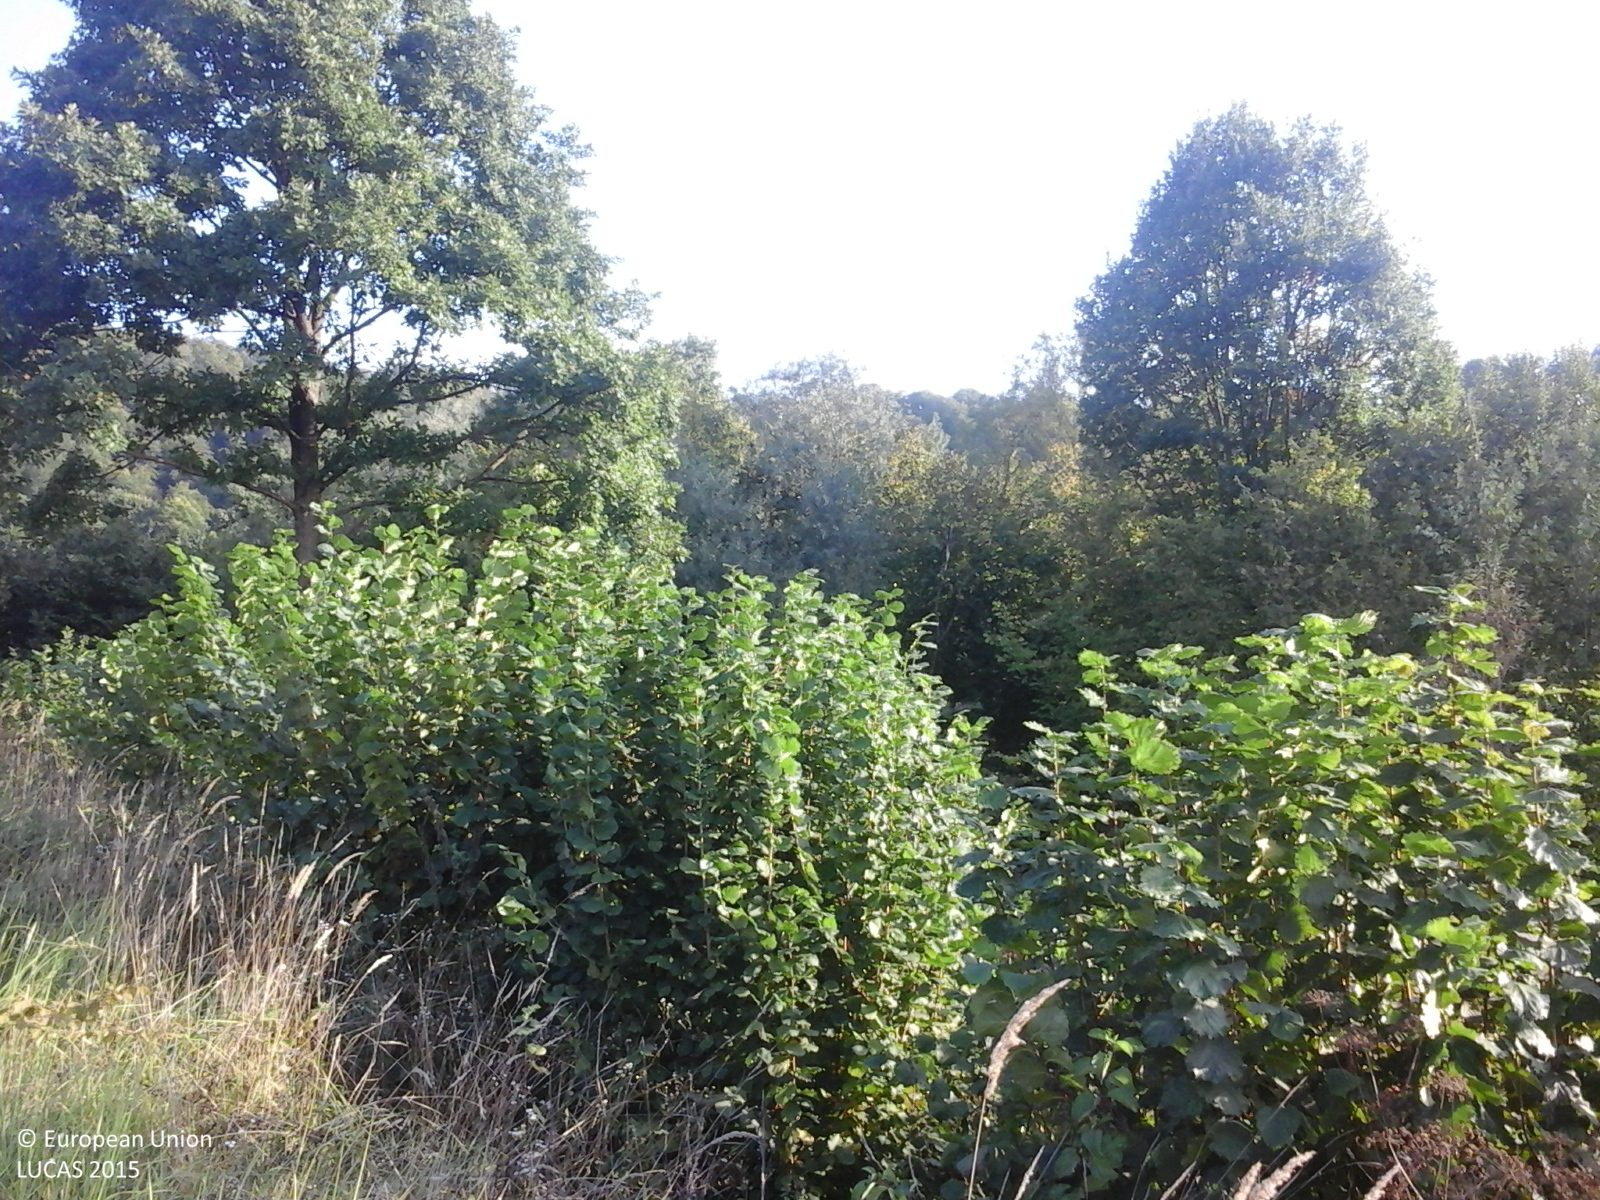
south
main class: Woodland
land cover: Broadleaved woodland
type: broadleaved evergreen forest
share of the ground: > 75 %
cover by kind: broadleaved forest trees 100 %
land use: Semi-natural and natural areas not in use
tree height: > 5 m
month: September
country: RO
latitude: 47.4059
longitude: 23.7941
